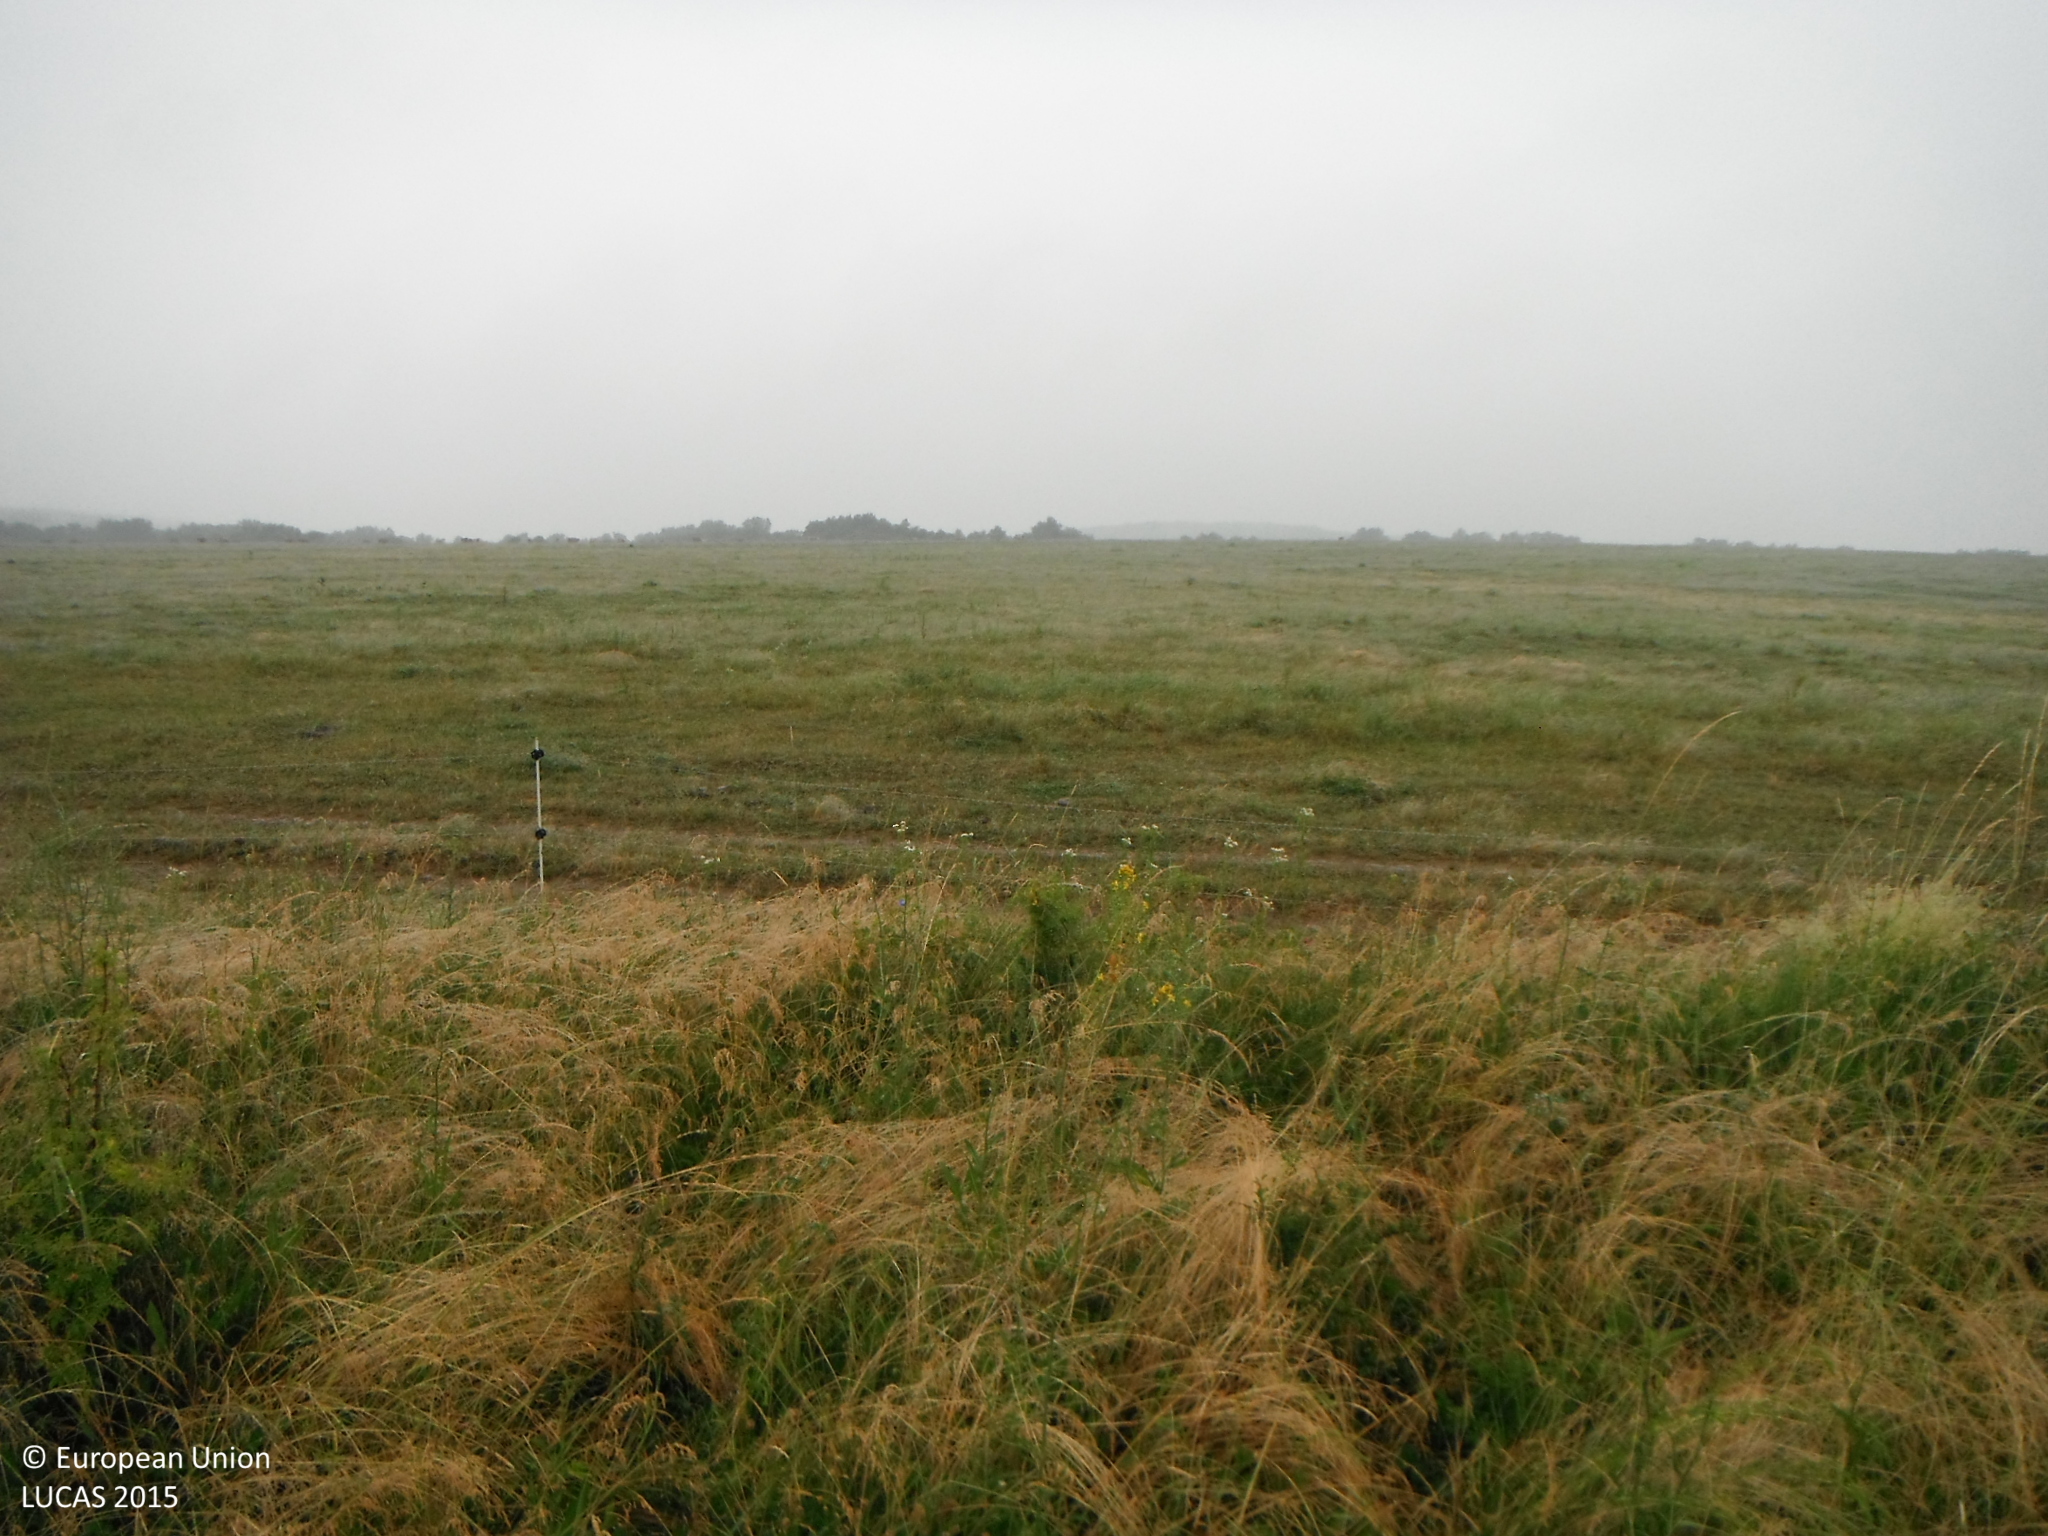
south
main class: Grassland
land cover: Grassland without tree/shrub cover
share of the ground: > 75 %
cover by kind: herbaceous plants 100 %
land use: Agriculture (excluding fallow land and kitchen gardens)
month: June
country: SK
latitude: 48.1235
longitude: 19.0345
